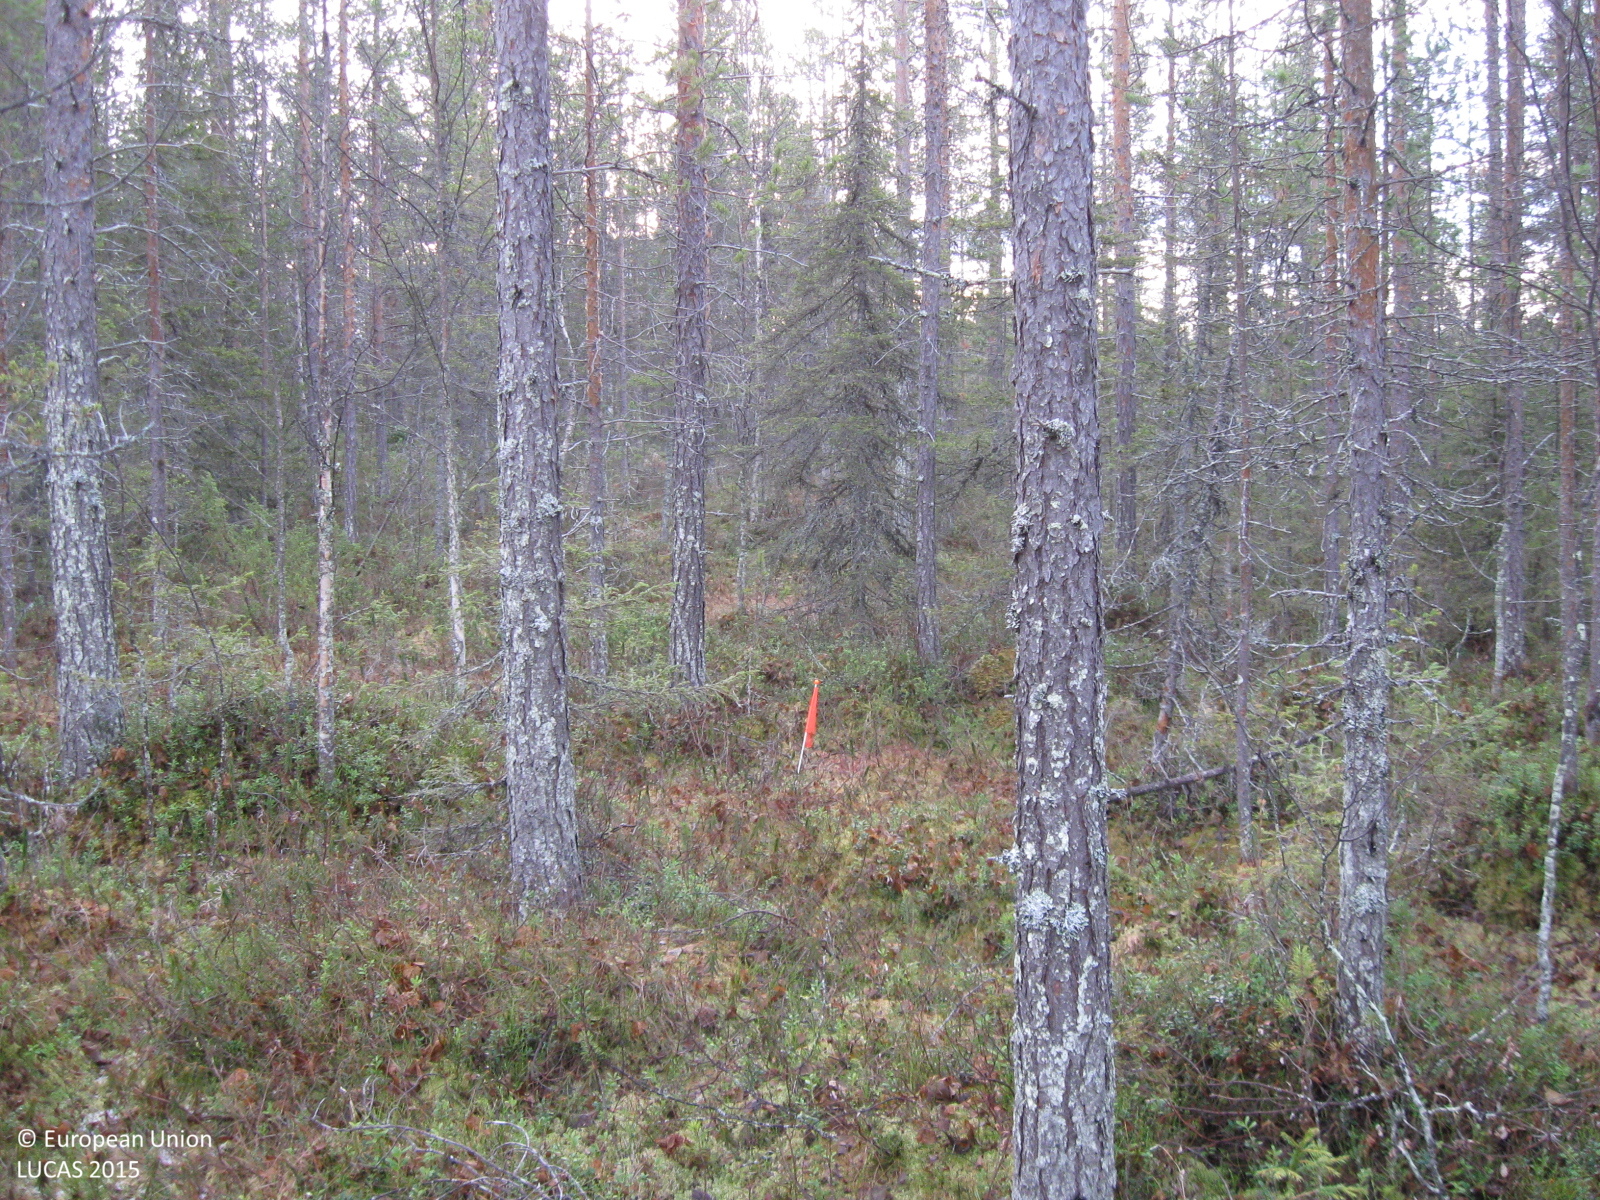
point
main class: Woodland
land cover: Pine dominated coniferous woodland
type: mire and swamp forests
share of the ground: 50 - 75 %
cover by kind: coniferous forest trees 60 %, shrubs 15 %, broadleaved forest trees 10 %, lichens and mosses 10 %, herbaceous plants 5 %
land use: Forestry
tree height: > 5 m
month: November
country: SE
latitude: 66.0175
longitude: 20.5672
